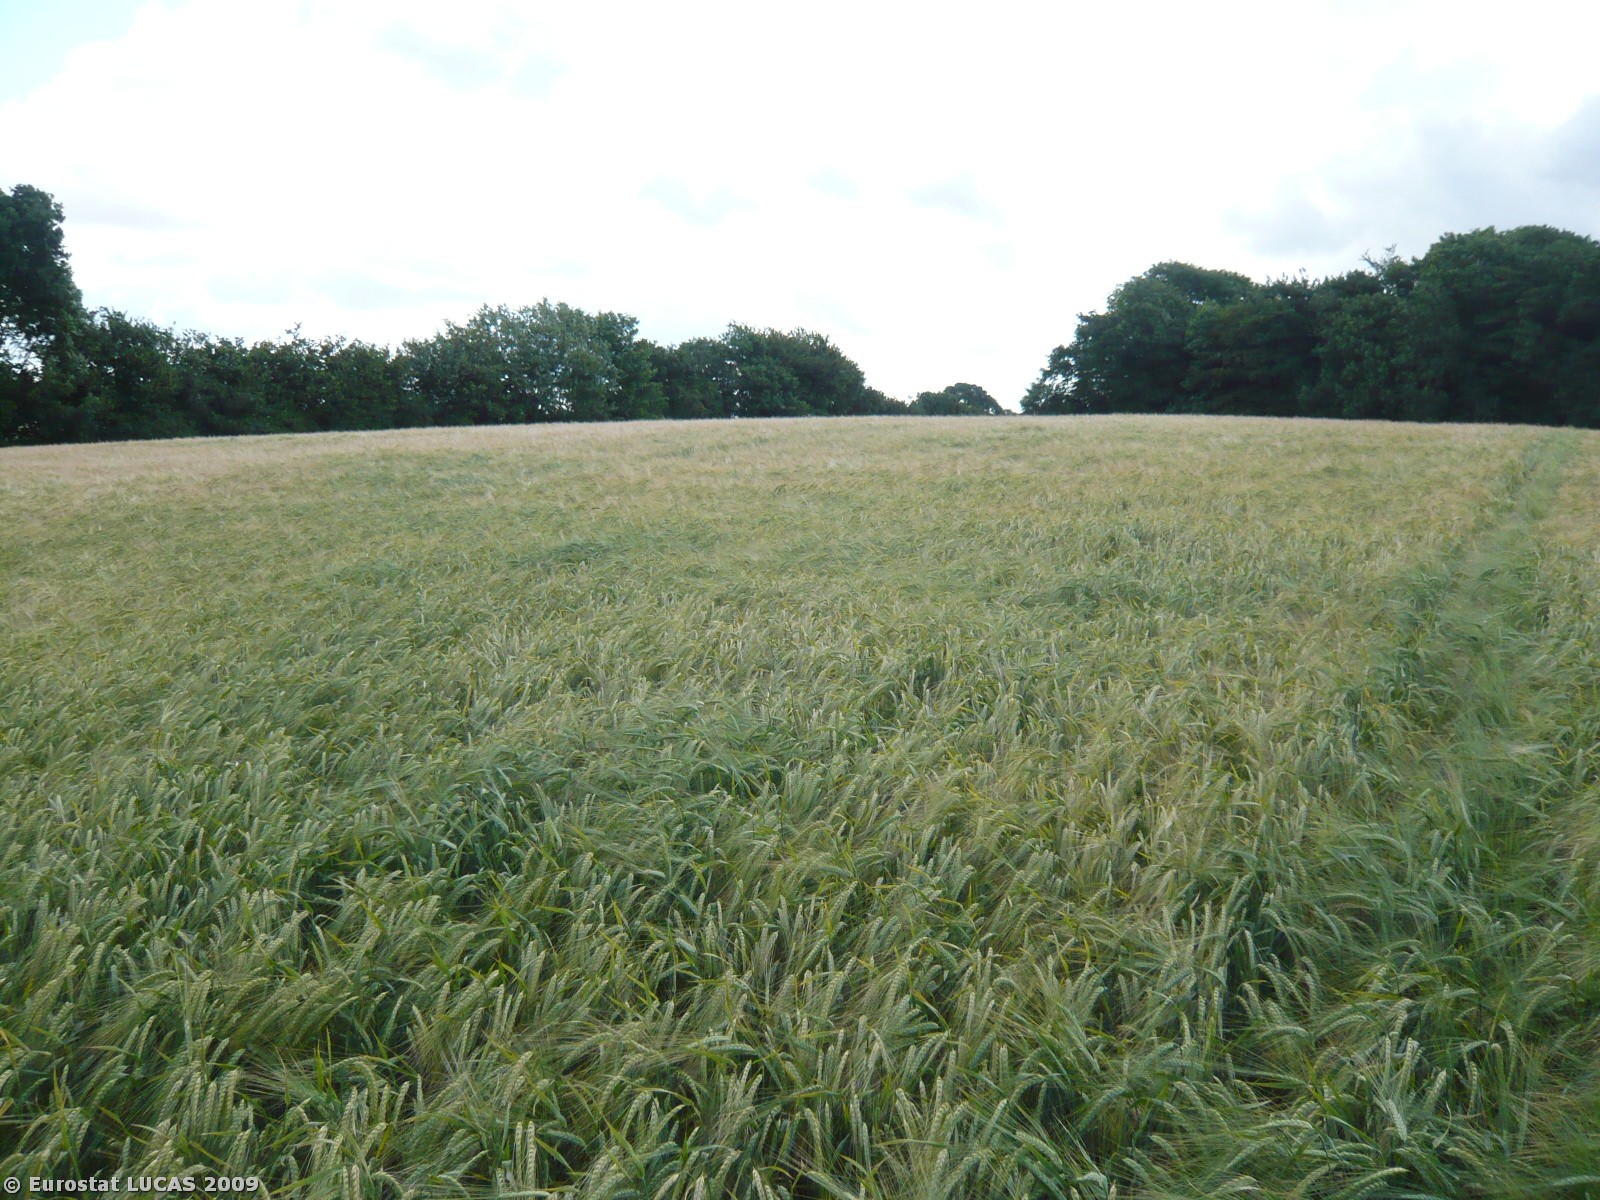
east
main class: Cropland
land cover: Barley
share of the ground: > 75 %
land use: Agriculture (excluding fallow land and kitchen gardens)
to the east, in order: Barley; Broadleaved woodland; Barley
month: July
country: DK
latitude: 55.4687
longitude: 10.1422
